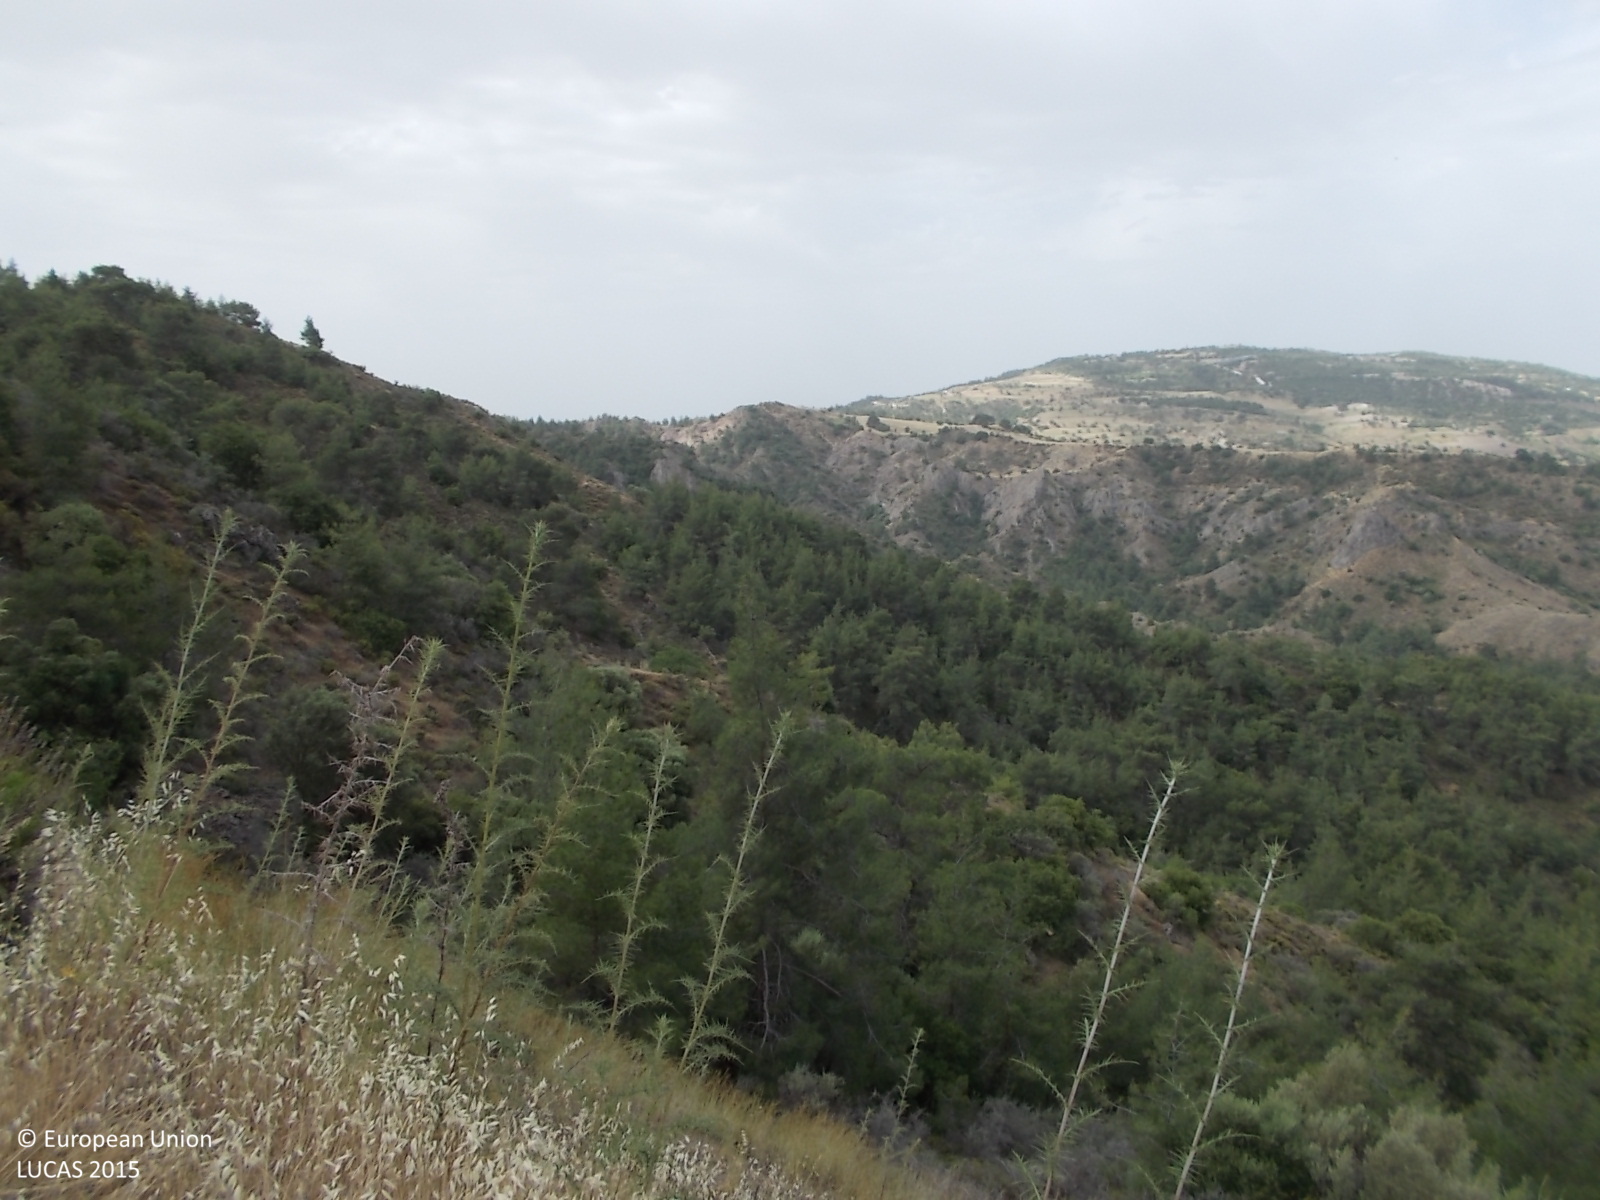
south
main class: Shrubland
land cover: Shrubland without tree cover
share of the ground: 10 - 25 %
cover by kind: herbaceous plants 75 %, shrubs 25 %
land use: Semi-natural and natural areas not in use
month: May
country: CY
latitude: 34.9582
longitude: 32.5733
